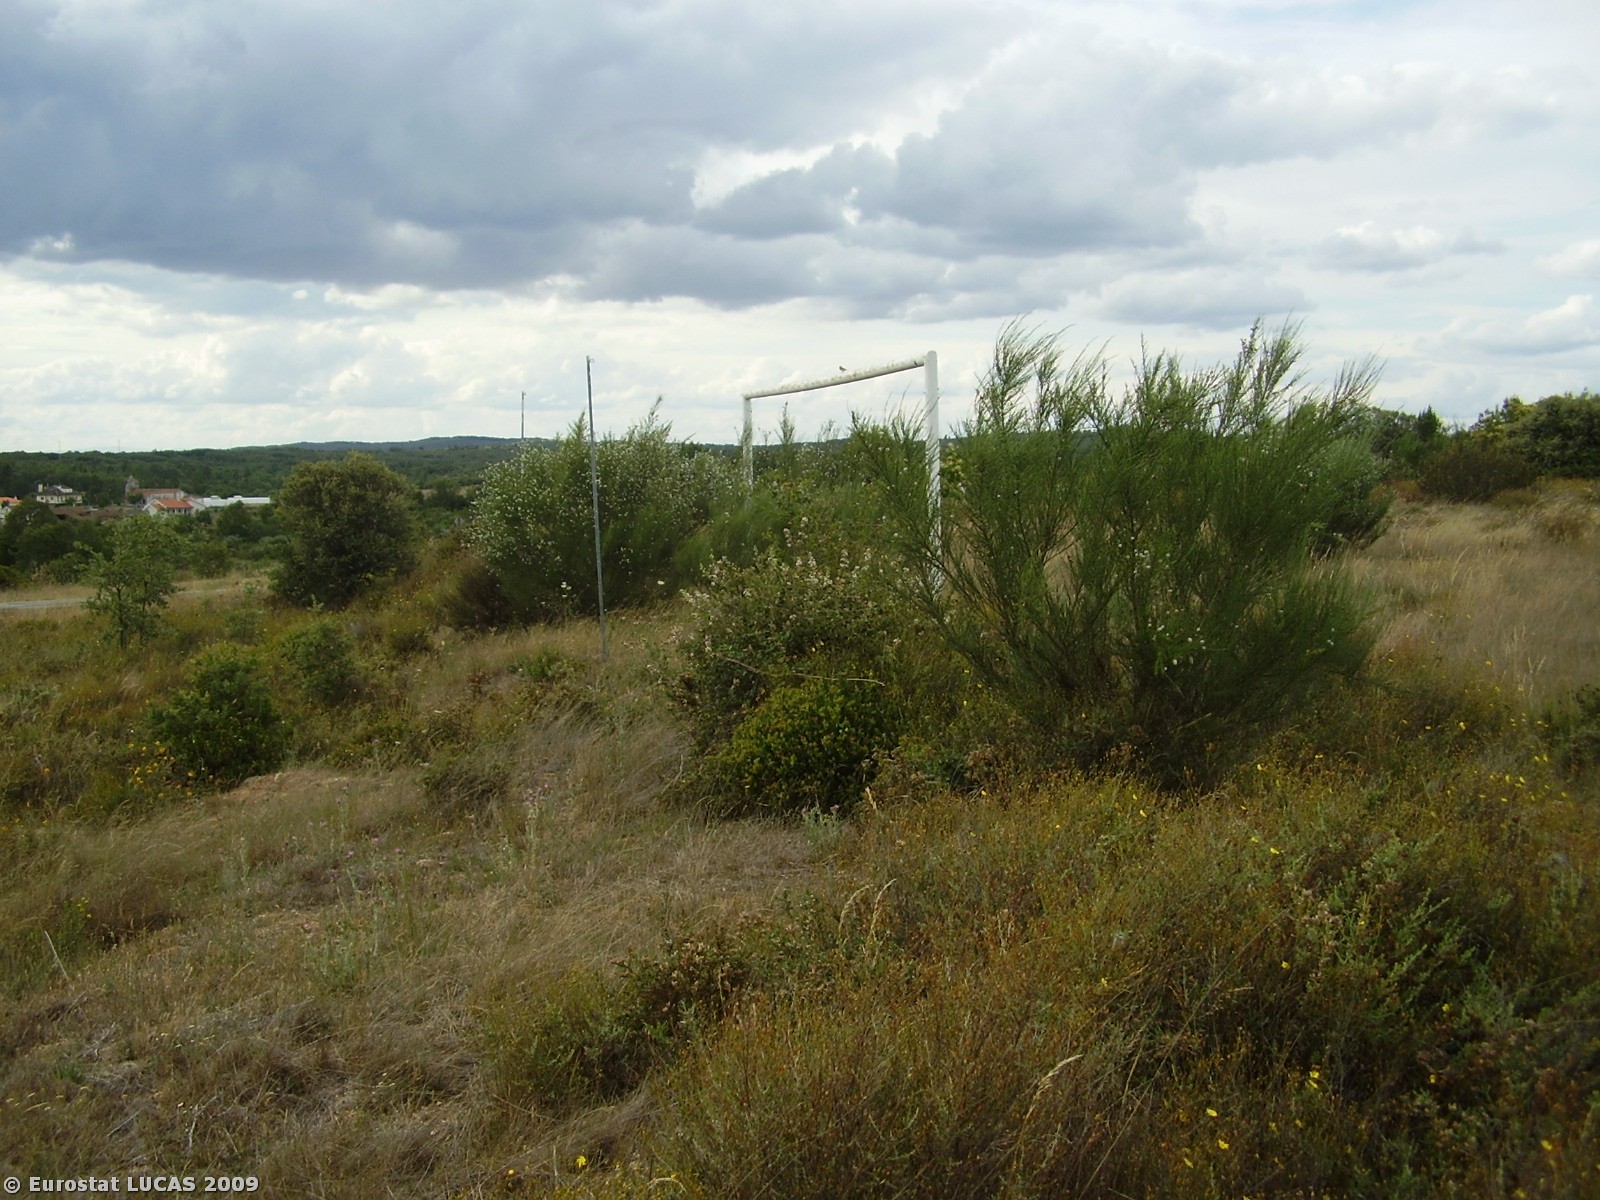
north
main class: Grassland
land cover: Spontaneously vegetated surfaces
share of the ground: > 75 %
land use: Unused
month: June
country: PT
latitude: 41.6230
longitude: -6.2662
